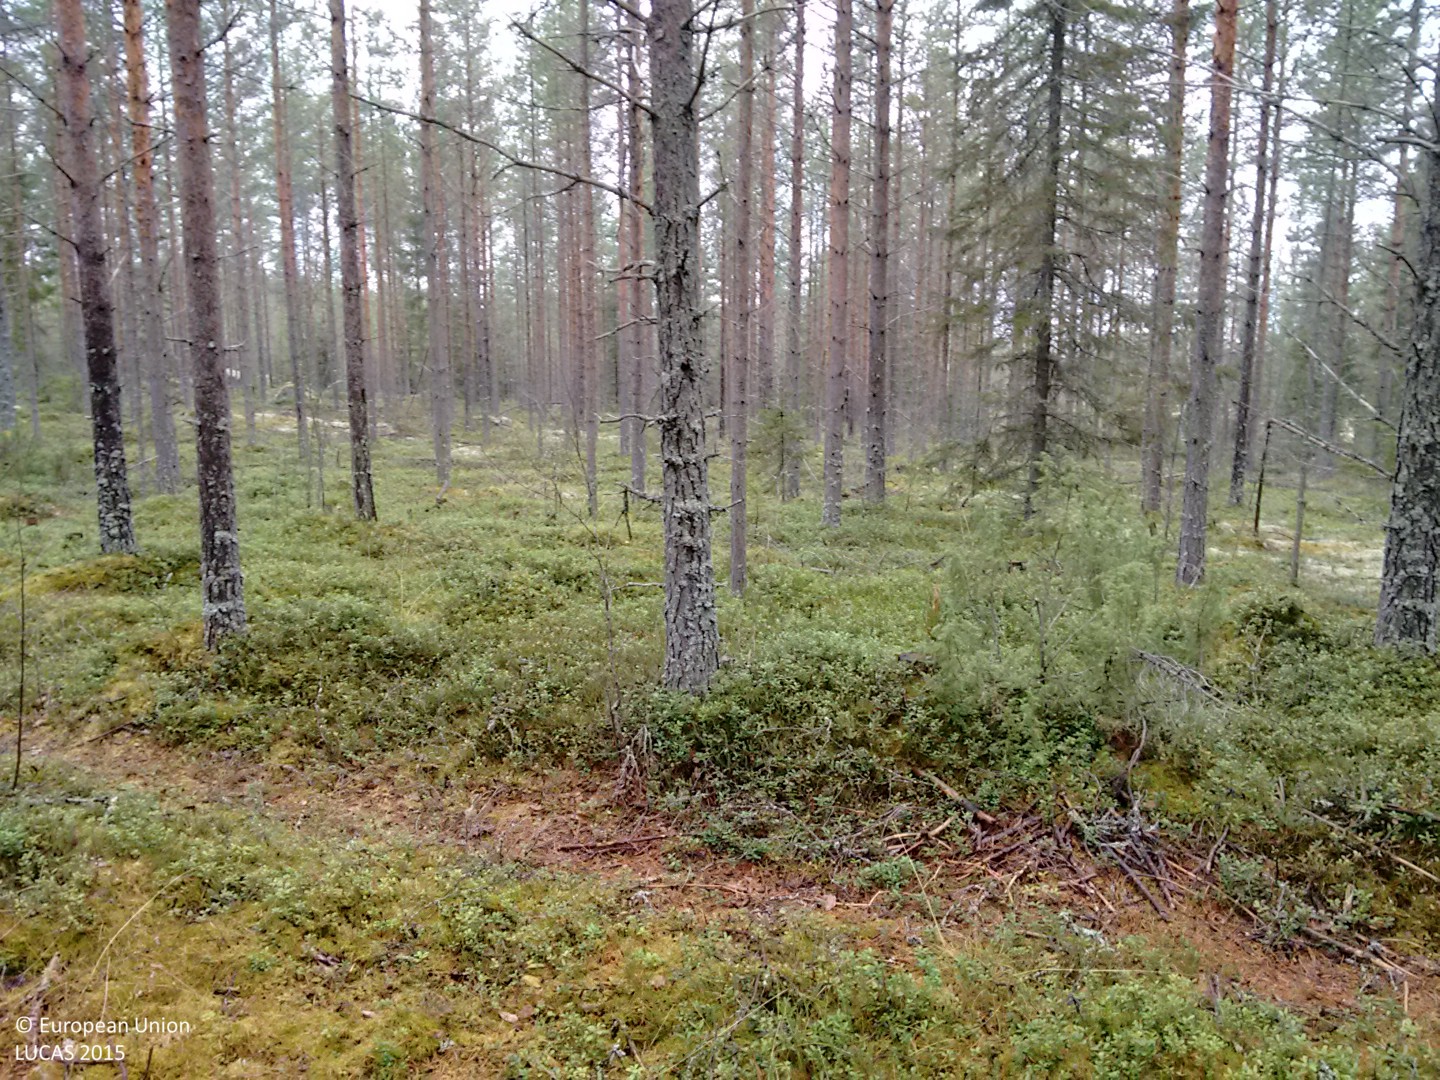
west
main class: Woodland
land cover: Pine dominated coniferous woodland
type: boreal forest
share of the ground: 50 - 75 %
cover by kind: coniferous forest trees 70 %, shrubs 20 %, lichens and mosses 10 %
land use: Forestry
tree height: > 5 m
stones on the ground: > 50 %
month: October
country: FI
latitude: 64.5248
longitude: 25.2325
